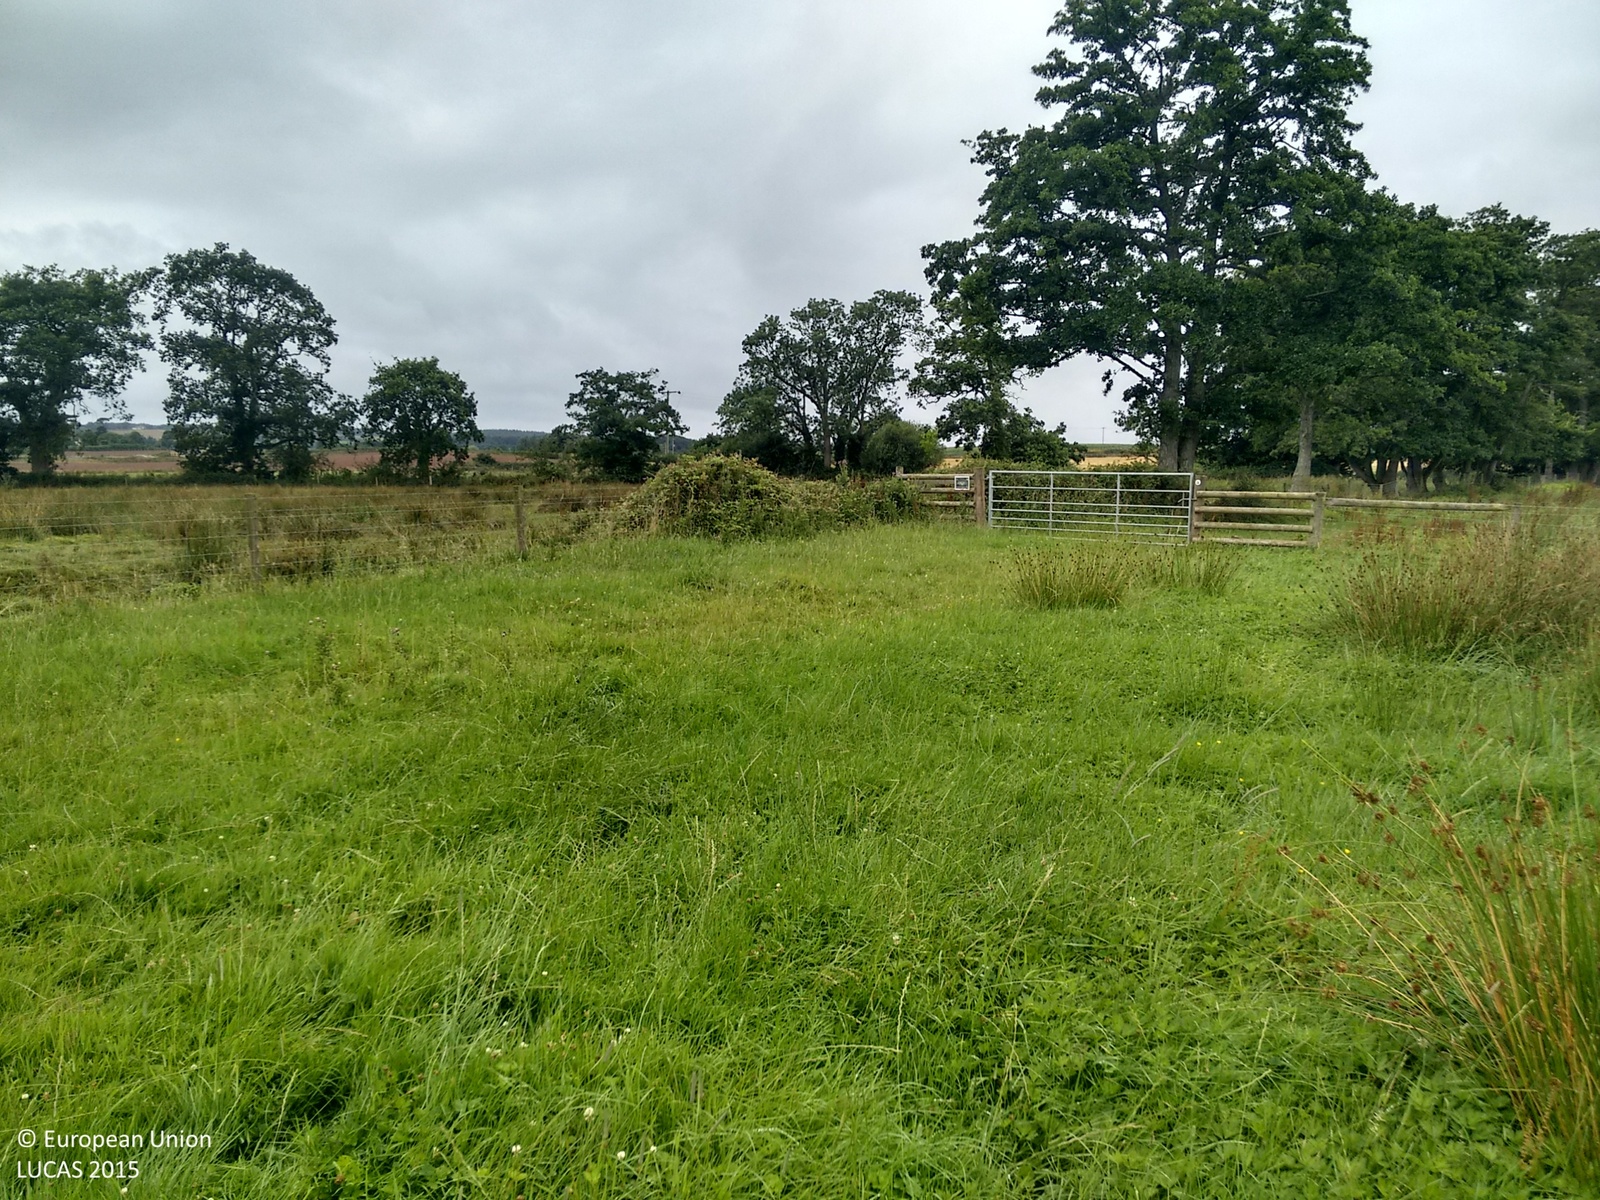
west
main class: Grassland
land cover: Grassland without tree/shrub cover
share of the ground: > 75 %
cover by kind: herbaceous plants 100 %
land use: Agriculture (excluding fallow land and kitchen gardens)
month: July
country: GB
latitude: 50.7681
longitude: -3.4539
